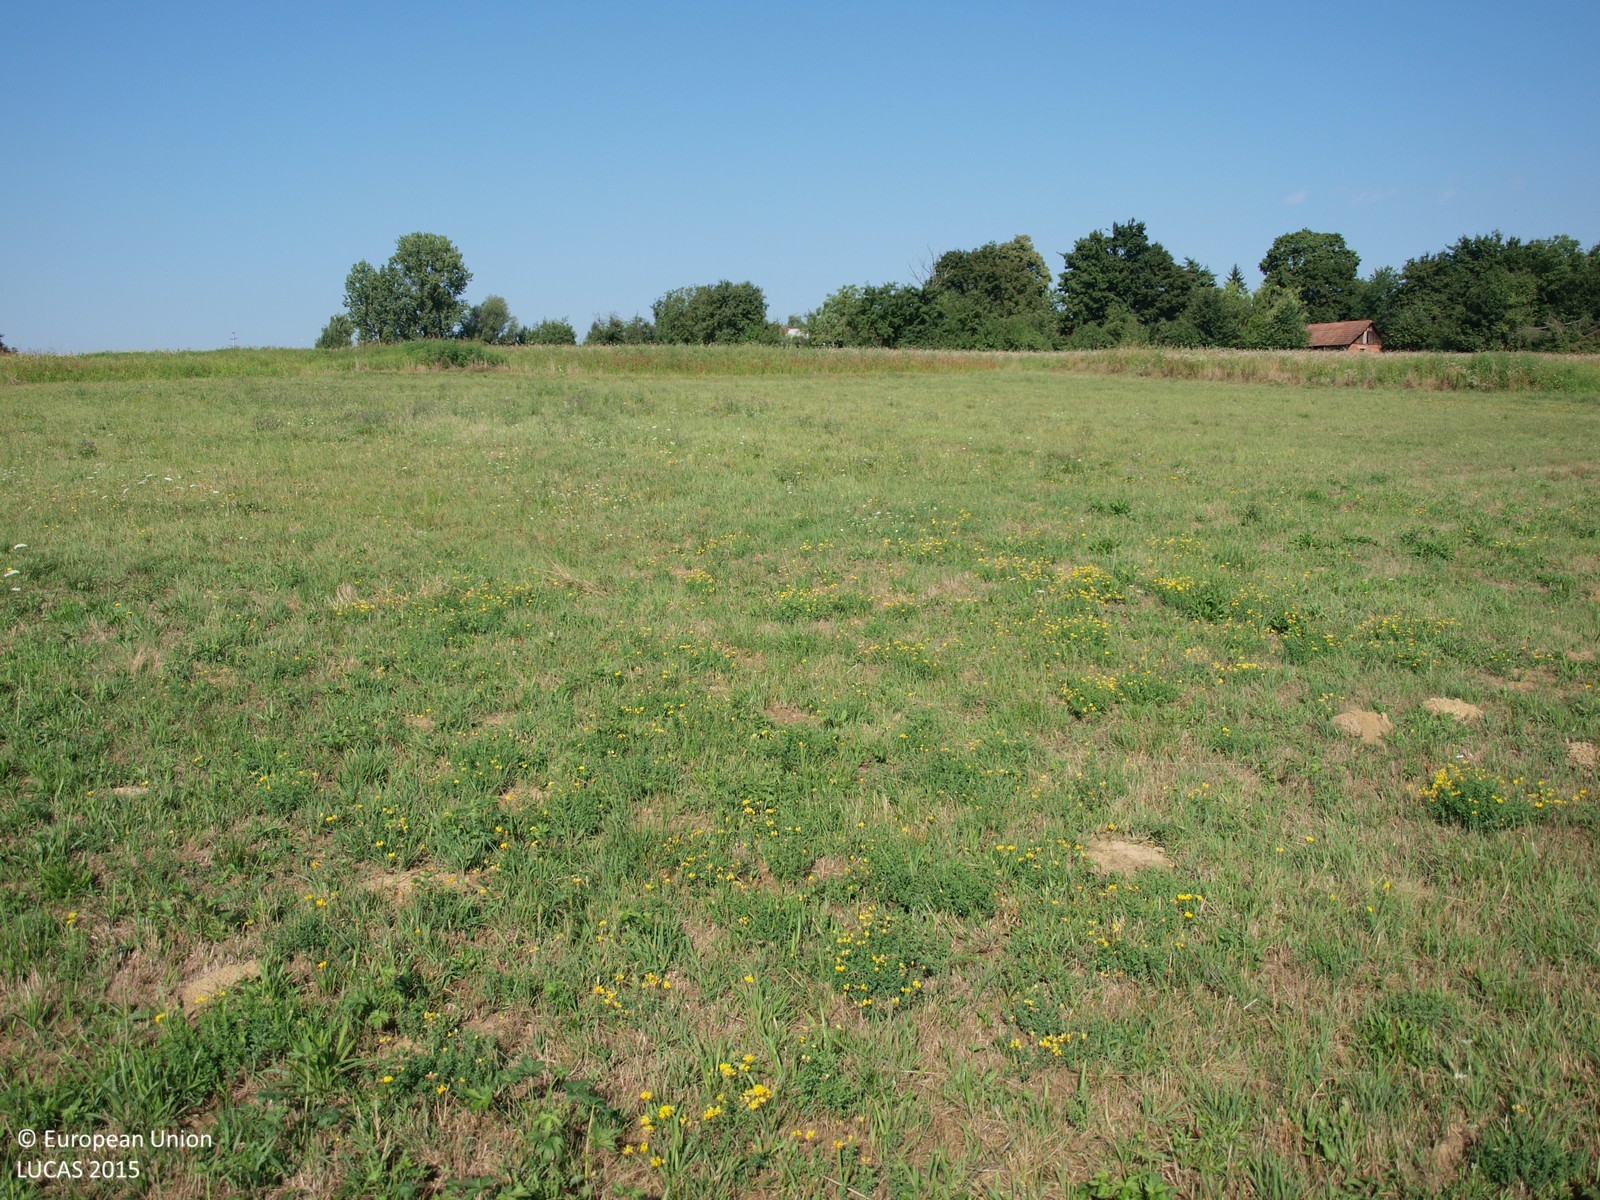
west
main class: Grassland
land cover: Grassland without tree/shrub cover
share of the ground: > 75 %
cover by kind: herbaceous plants 100 %
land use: Agriculture (excluding fallow land and kitchen gardens)
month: August
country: HR
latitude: 45.8974
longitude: 16.2497
